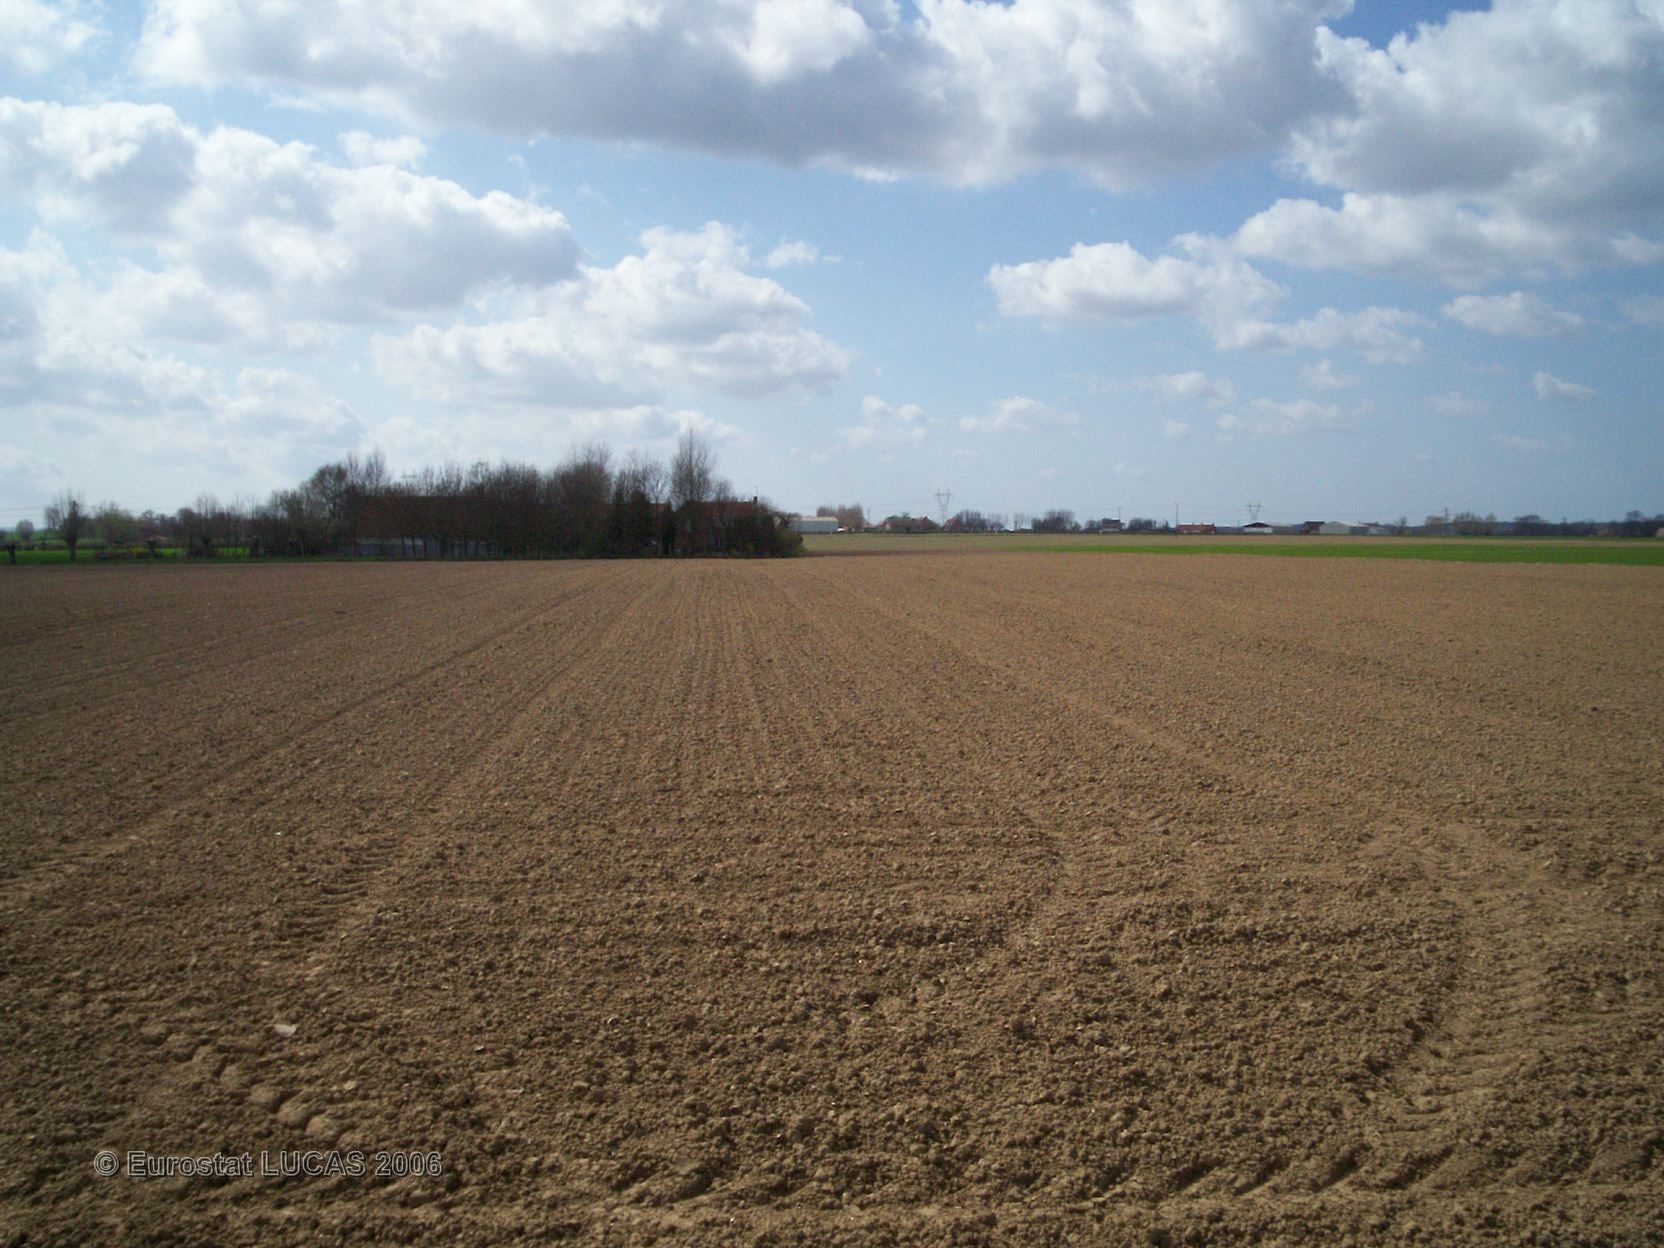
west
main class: Cropland
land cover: Sugar beet
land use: Agriculture (excluding fallow land and kitchen gardens)
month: May
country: FR
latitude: 50.8093
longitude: 2.3085
